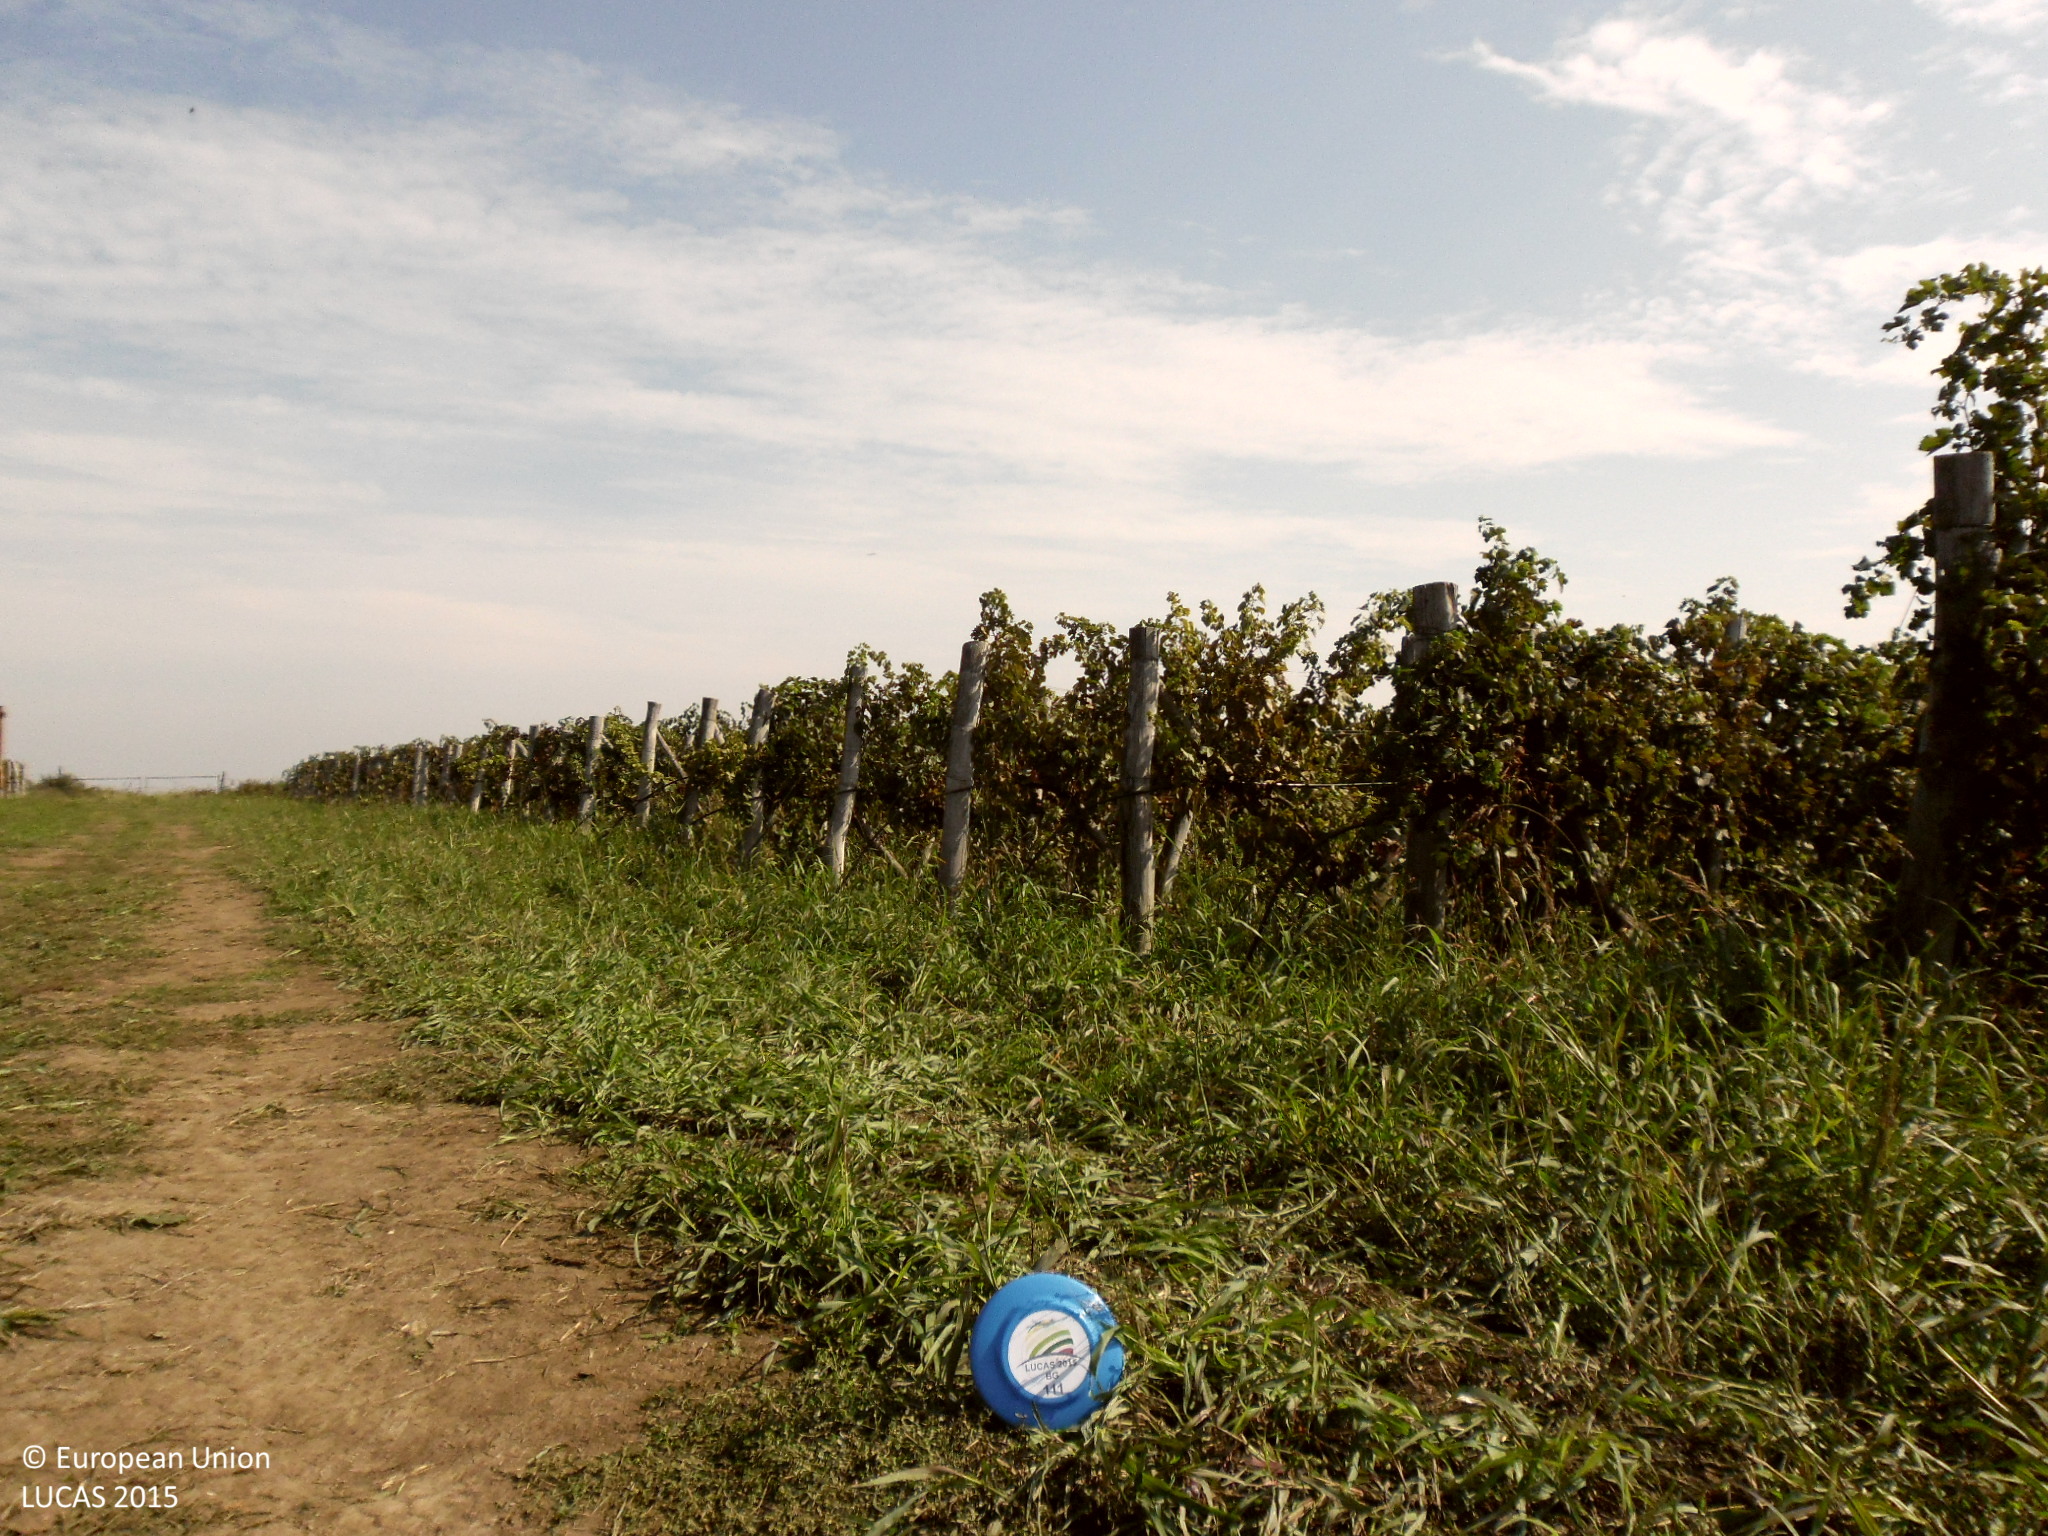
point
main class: Artificial land
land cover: Non built-up linear features
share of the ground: > 75 %
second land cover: Grassland without tree/shrub cover
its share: 25 - 50 %
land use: Road transport
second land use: Agriculture (excluding fallow land and kitchen gardens)
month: October
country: BG
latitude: 44.0135
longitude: 22.7740
